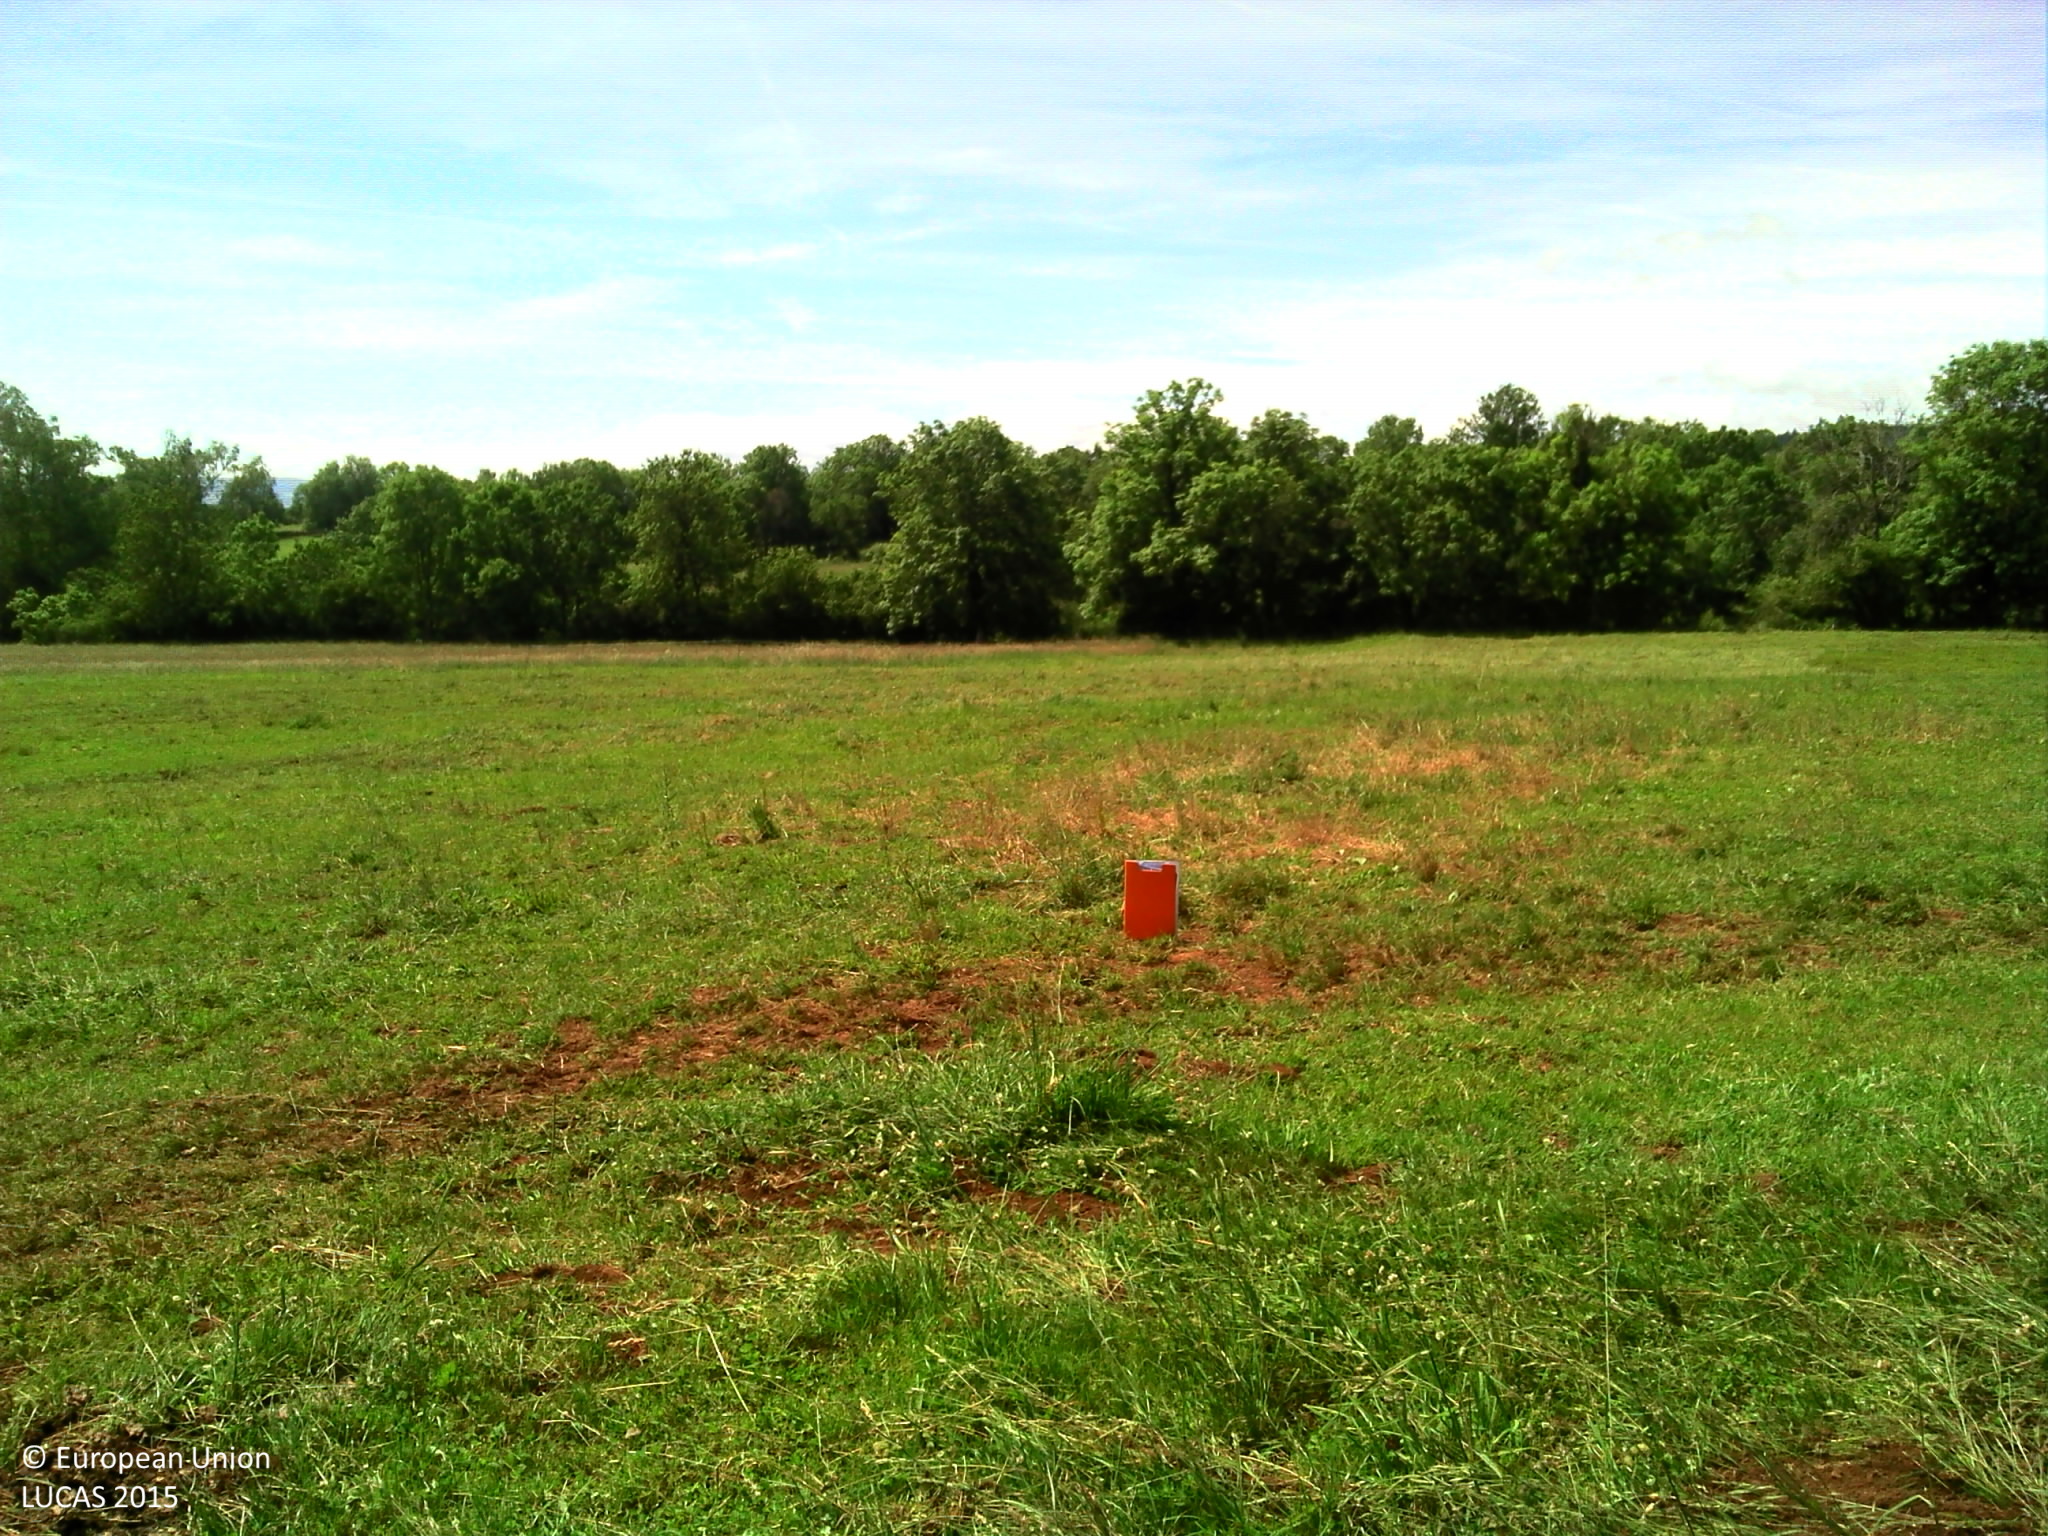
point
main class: Grassland
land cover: Grassland without tree/shrub cover
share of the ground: > 75 %
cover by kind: herbaceous plants 100 %
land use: Agriculture (excluding fallow land and kitchen gardens)
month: June
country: FR
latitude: 45.0305
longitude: 2.9066
